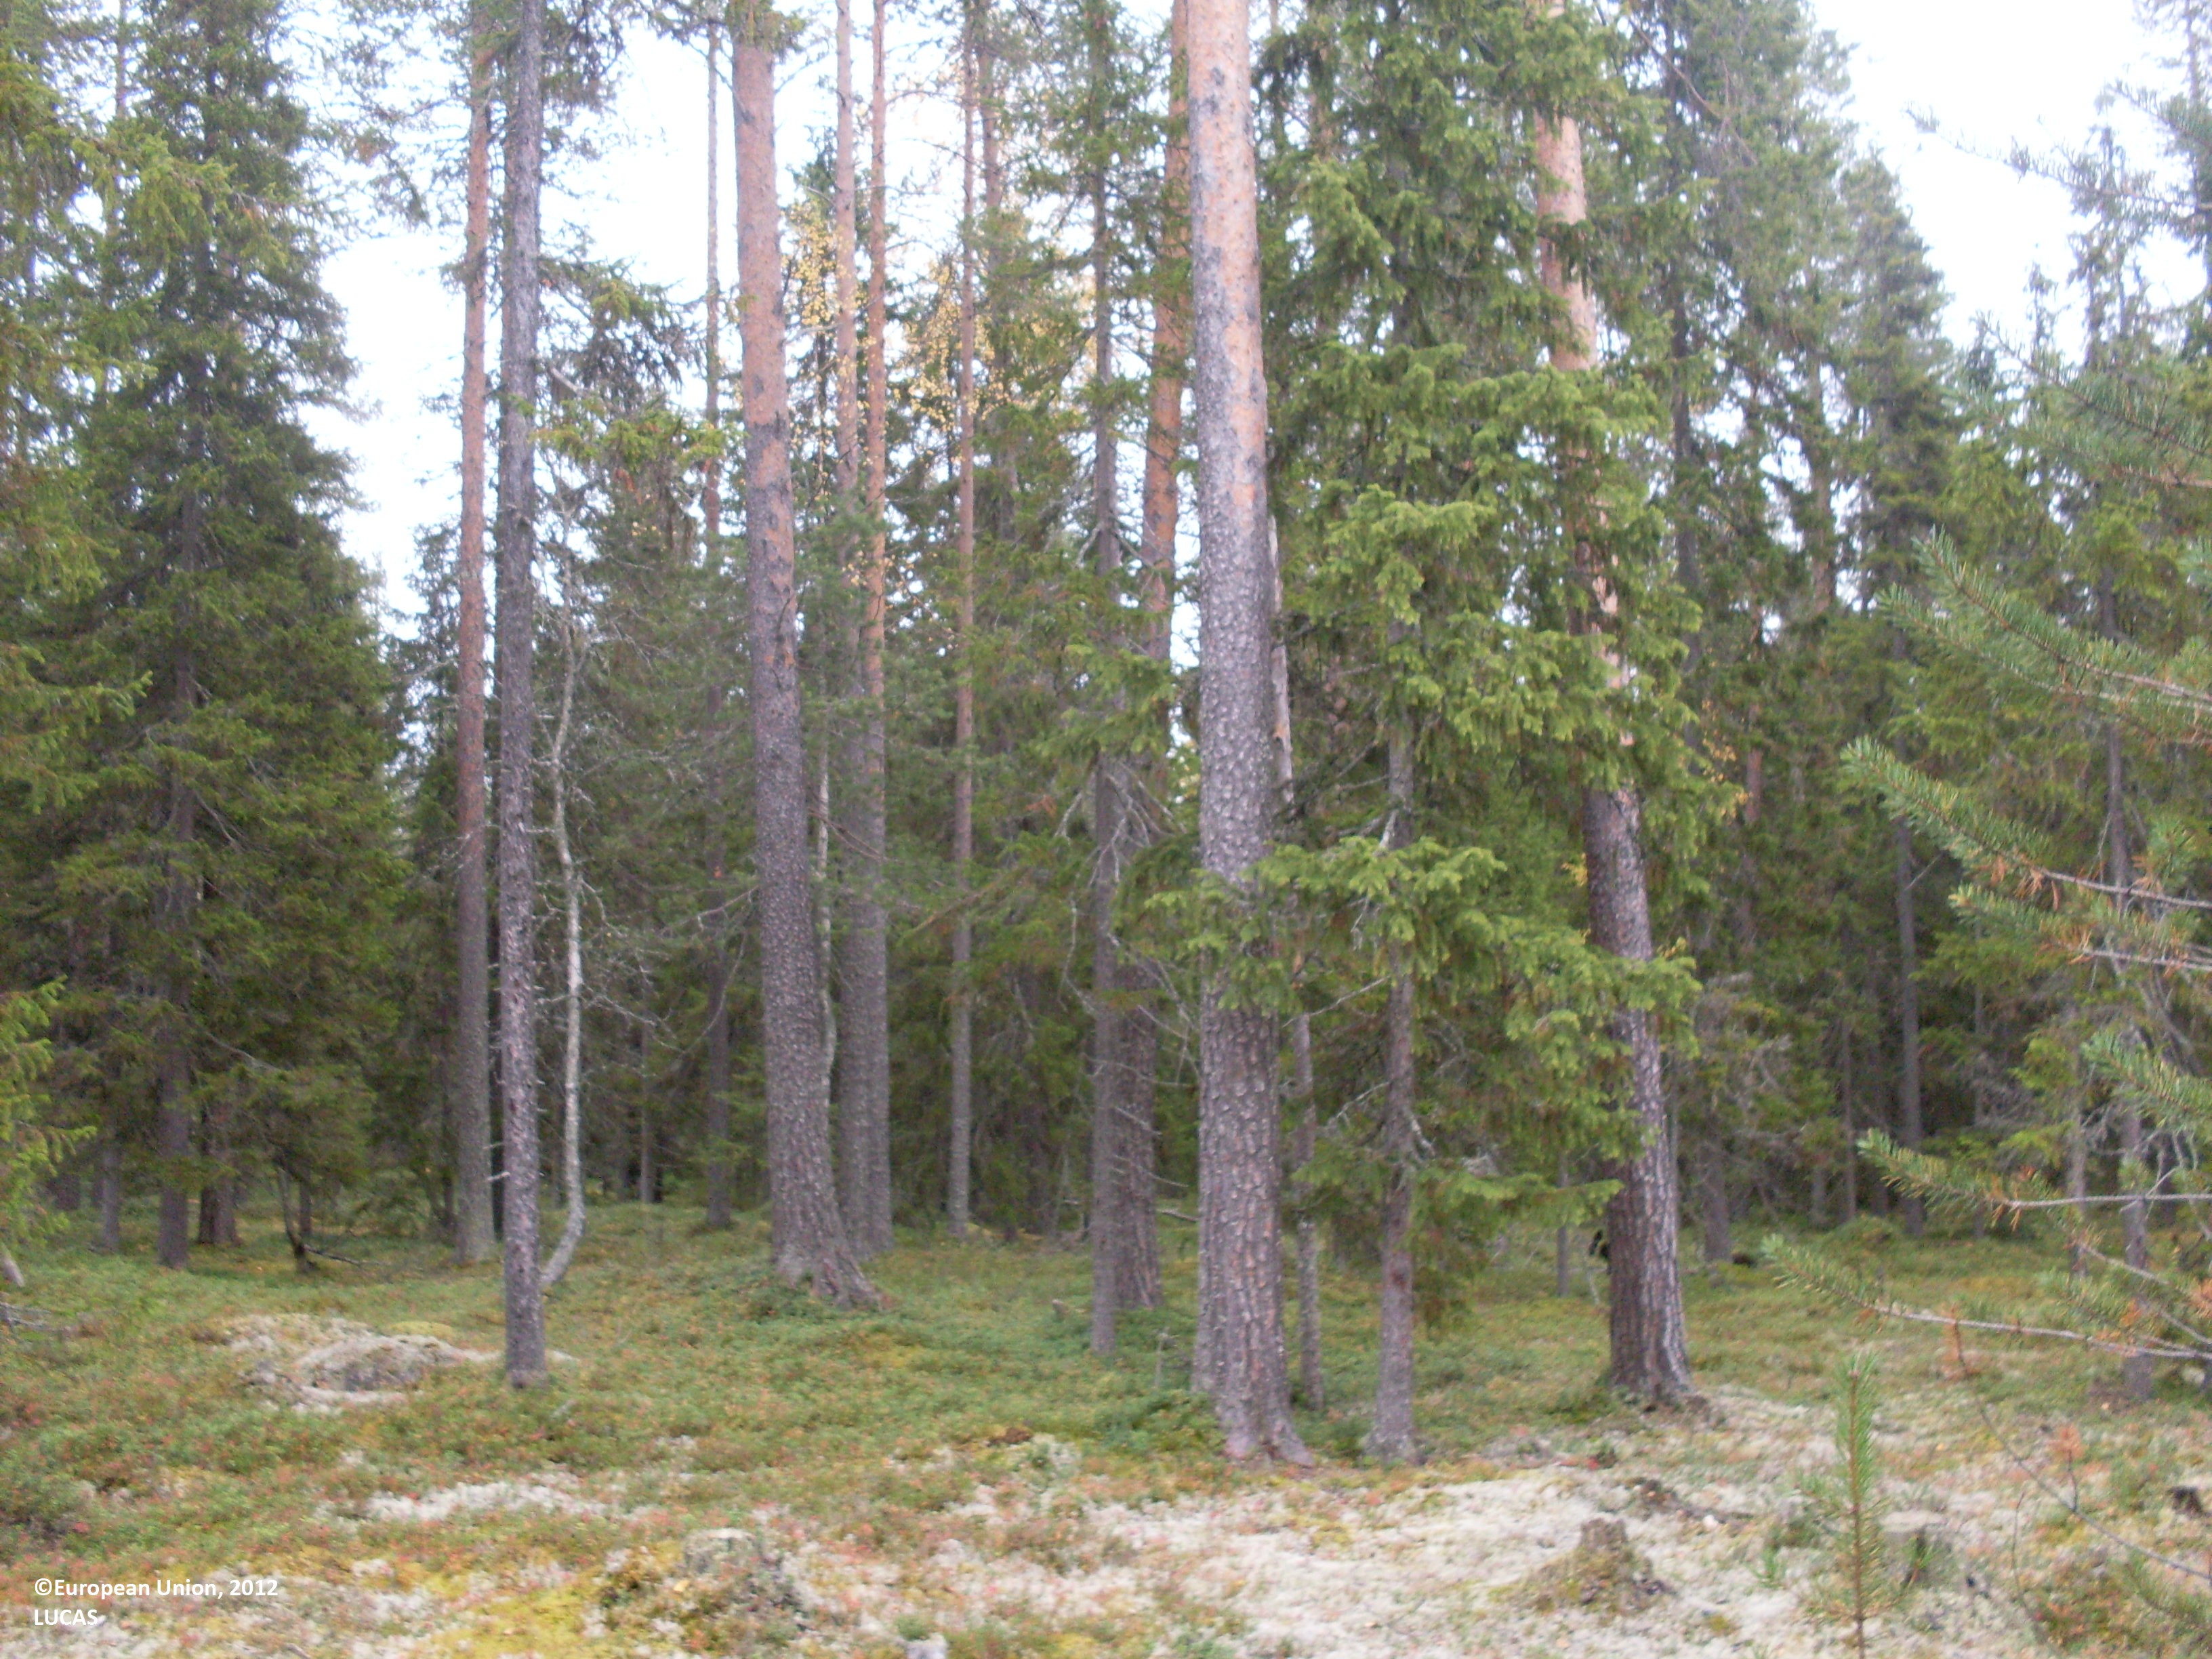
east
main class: Woodland
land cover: Pine dominated mixed woodland
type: boreal forest
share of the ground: 50 - 75 %
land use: Forestry
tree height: > 5 m
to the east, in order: Pine dominated mixed woodland; Shrubland with sparse tree cover; Electric lines; Shrubland with sparse tree cover; Ditches and canals; Grassland without tree/shrub cover; Paved roads, cycling and walking lanes; Grassland without tree/shrub cover; Ditches and canals; Pine dominated mixed woodland; Ditches and canals; Pine dominated mixed woodland
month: September
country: FI
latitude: 64.6402
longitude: 28.9611
